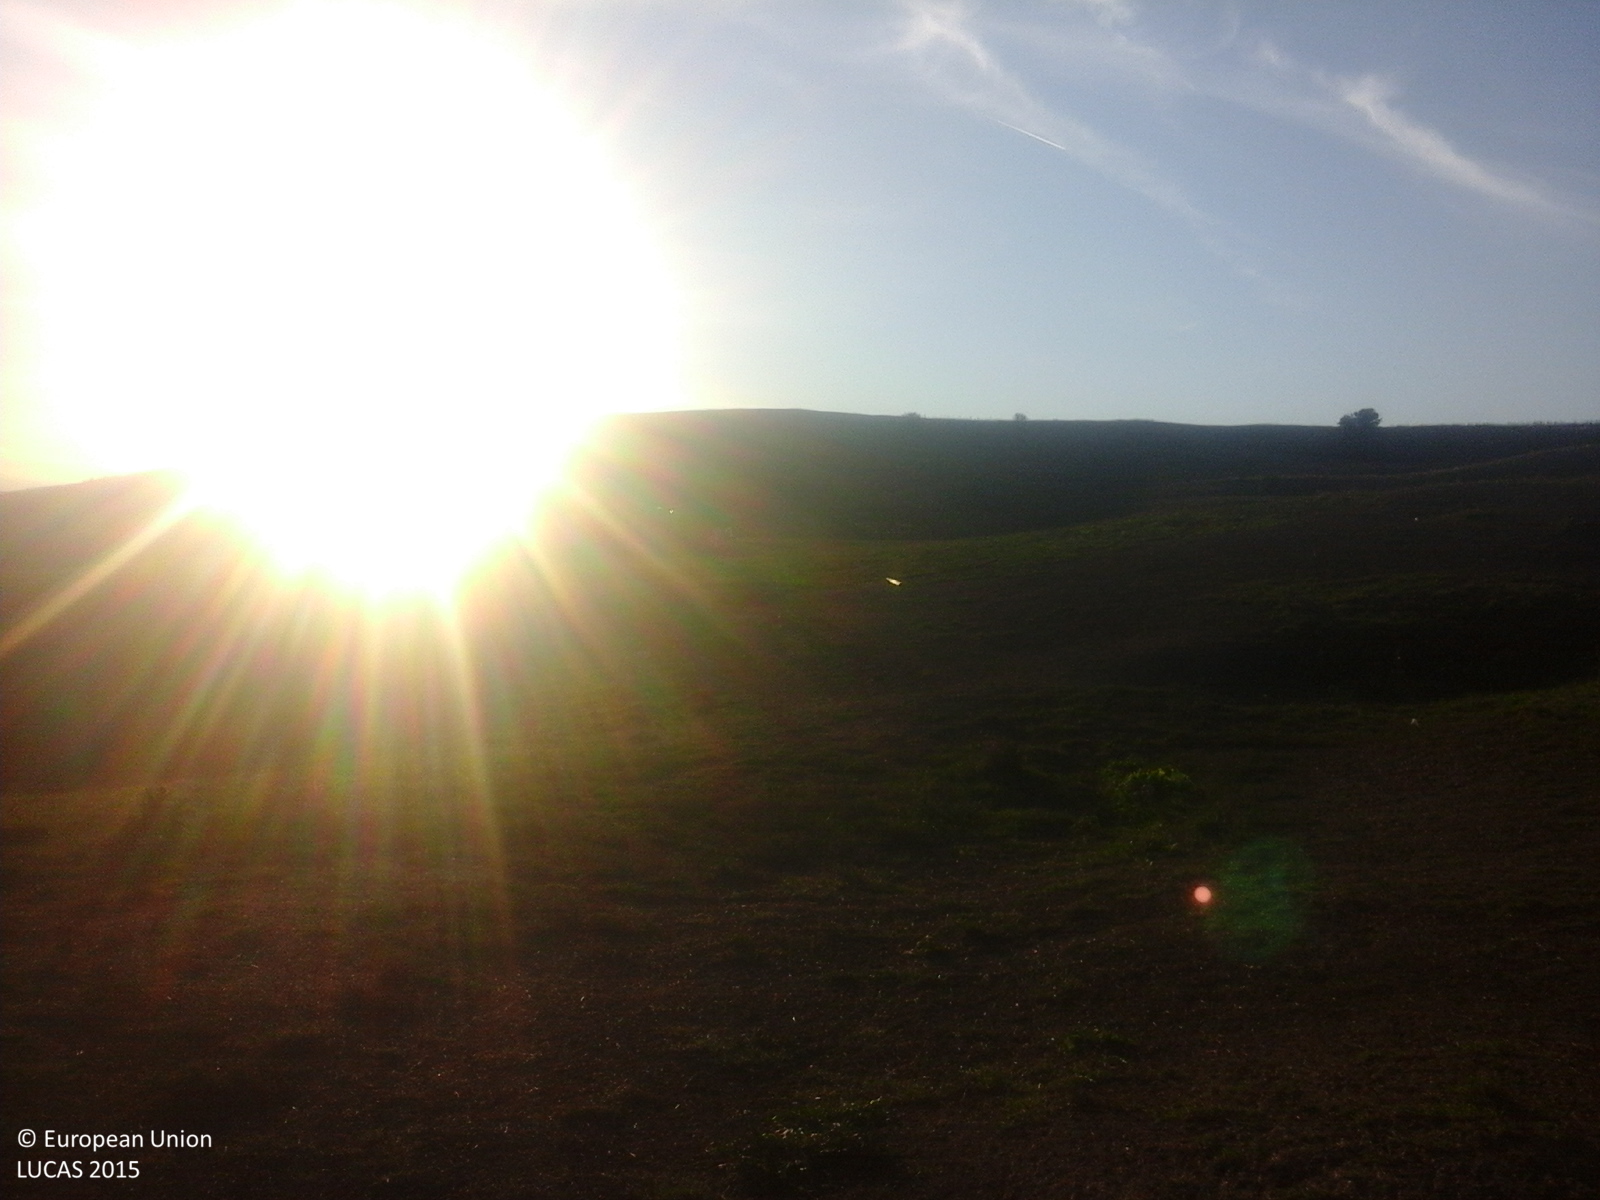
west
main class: Grassland
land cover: Grassland without tree/shrub cover
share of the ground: > 75 %
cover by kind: herbaceous plants 100 %
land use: Agriculture (excluding fallow land and kitchen gardens)
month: October
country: RO
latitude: 45.9243
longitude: 24.0914
